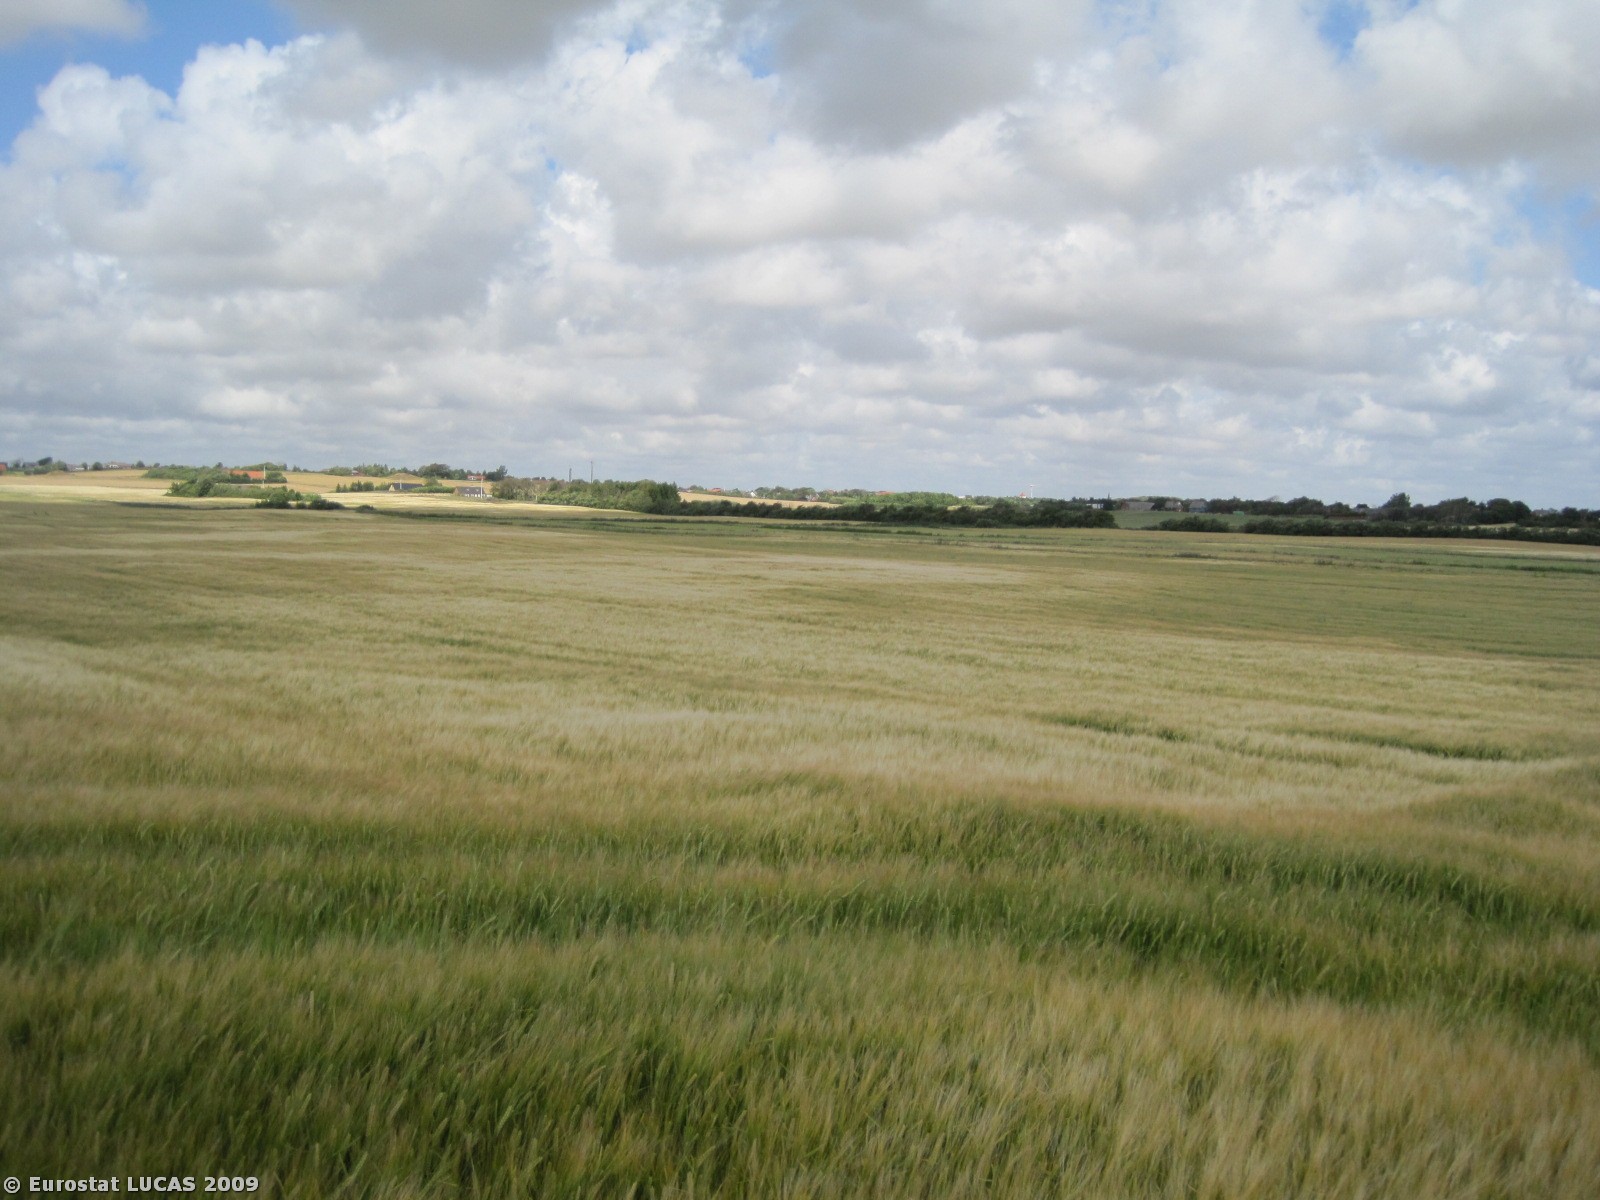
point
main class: Cropland
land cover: Barley
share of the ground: > 75 %
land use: Agriculture (excluding fallow land and kitchen gardens)
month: July
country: DK
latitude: 56.8803
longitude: 8.5088
